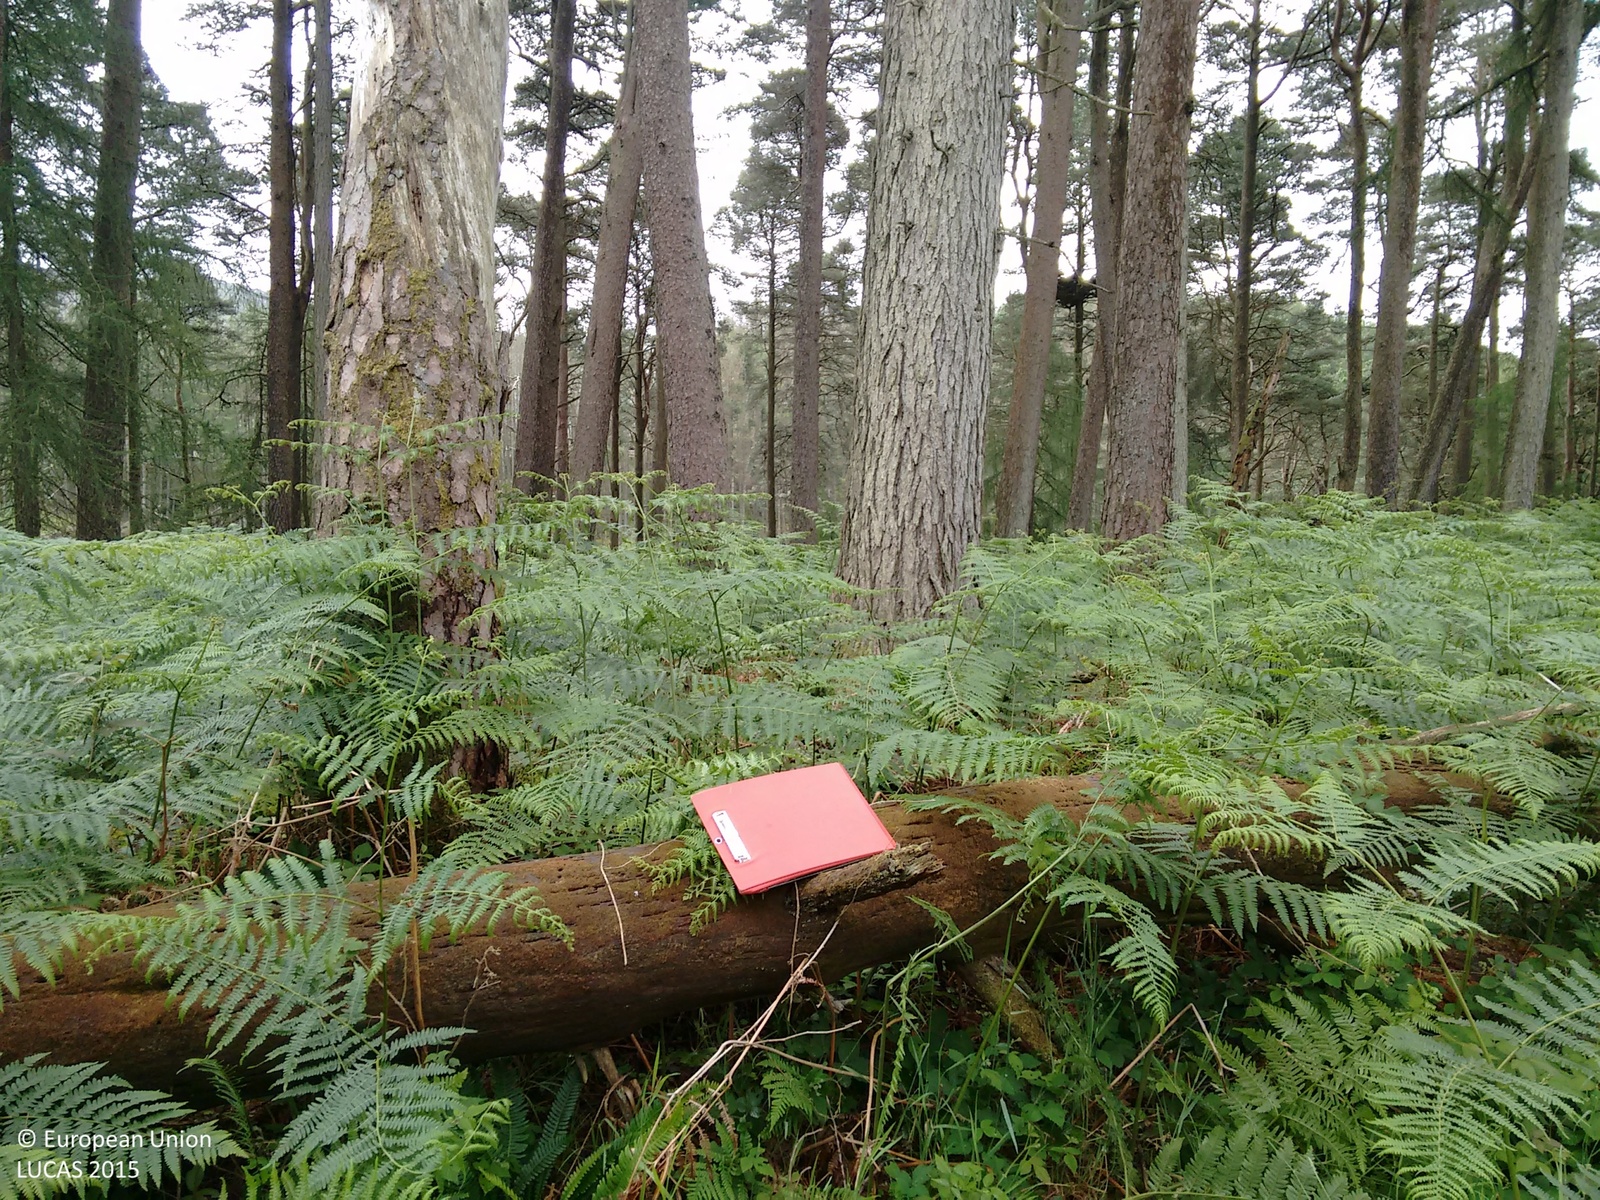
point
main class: Woodland
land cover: Other mixed woodland
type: hemiboreal forest and nemoral coniferous forest and mixed broadleaved-coniferous forest
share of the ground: > 75 %
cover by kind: coniferous forest trees 75 %, broadleaved forest trees 25 %
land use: Forestry
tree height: > 5 m
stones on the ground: < 10 %
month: July
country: GB
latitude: 55.0836
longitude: -4.4981
